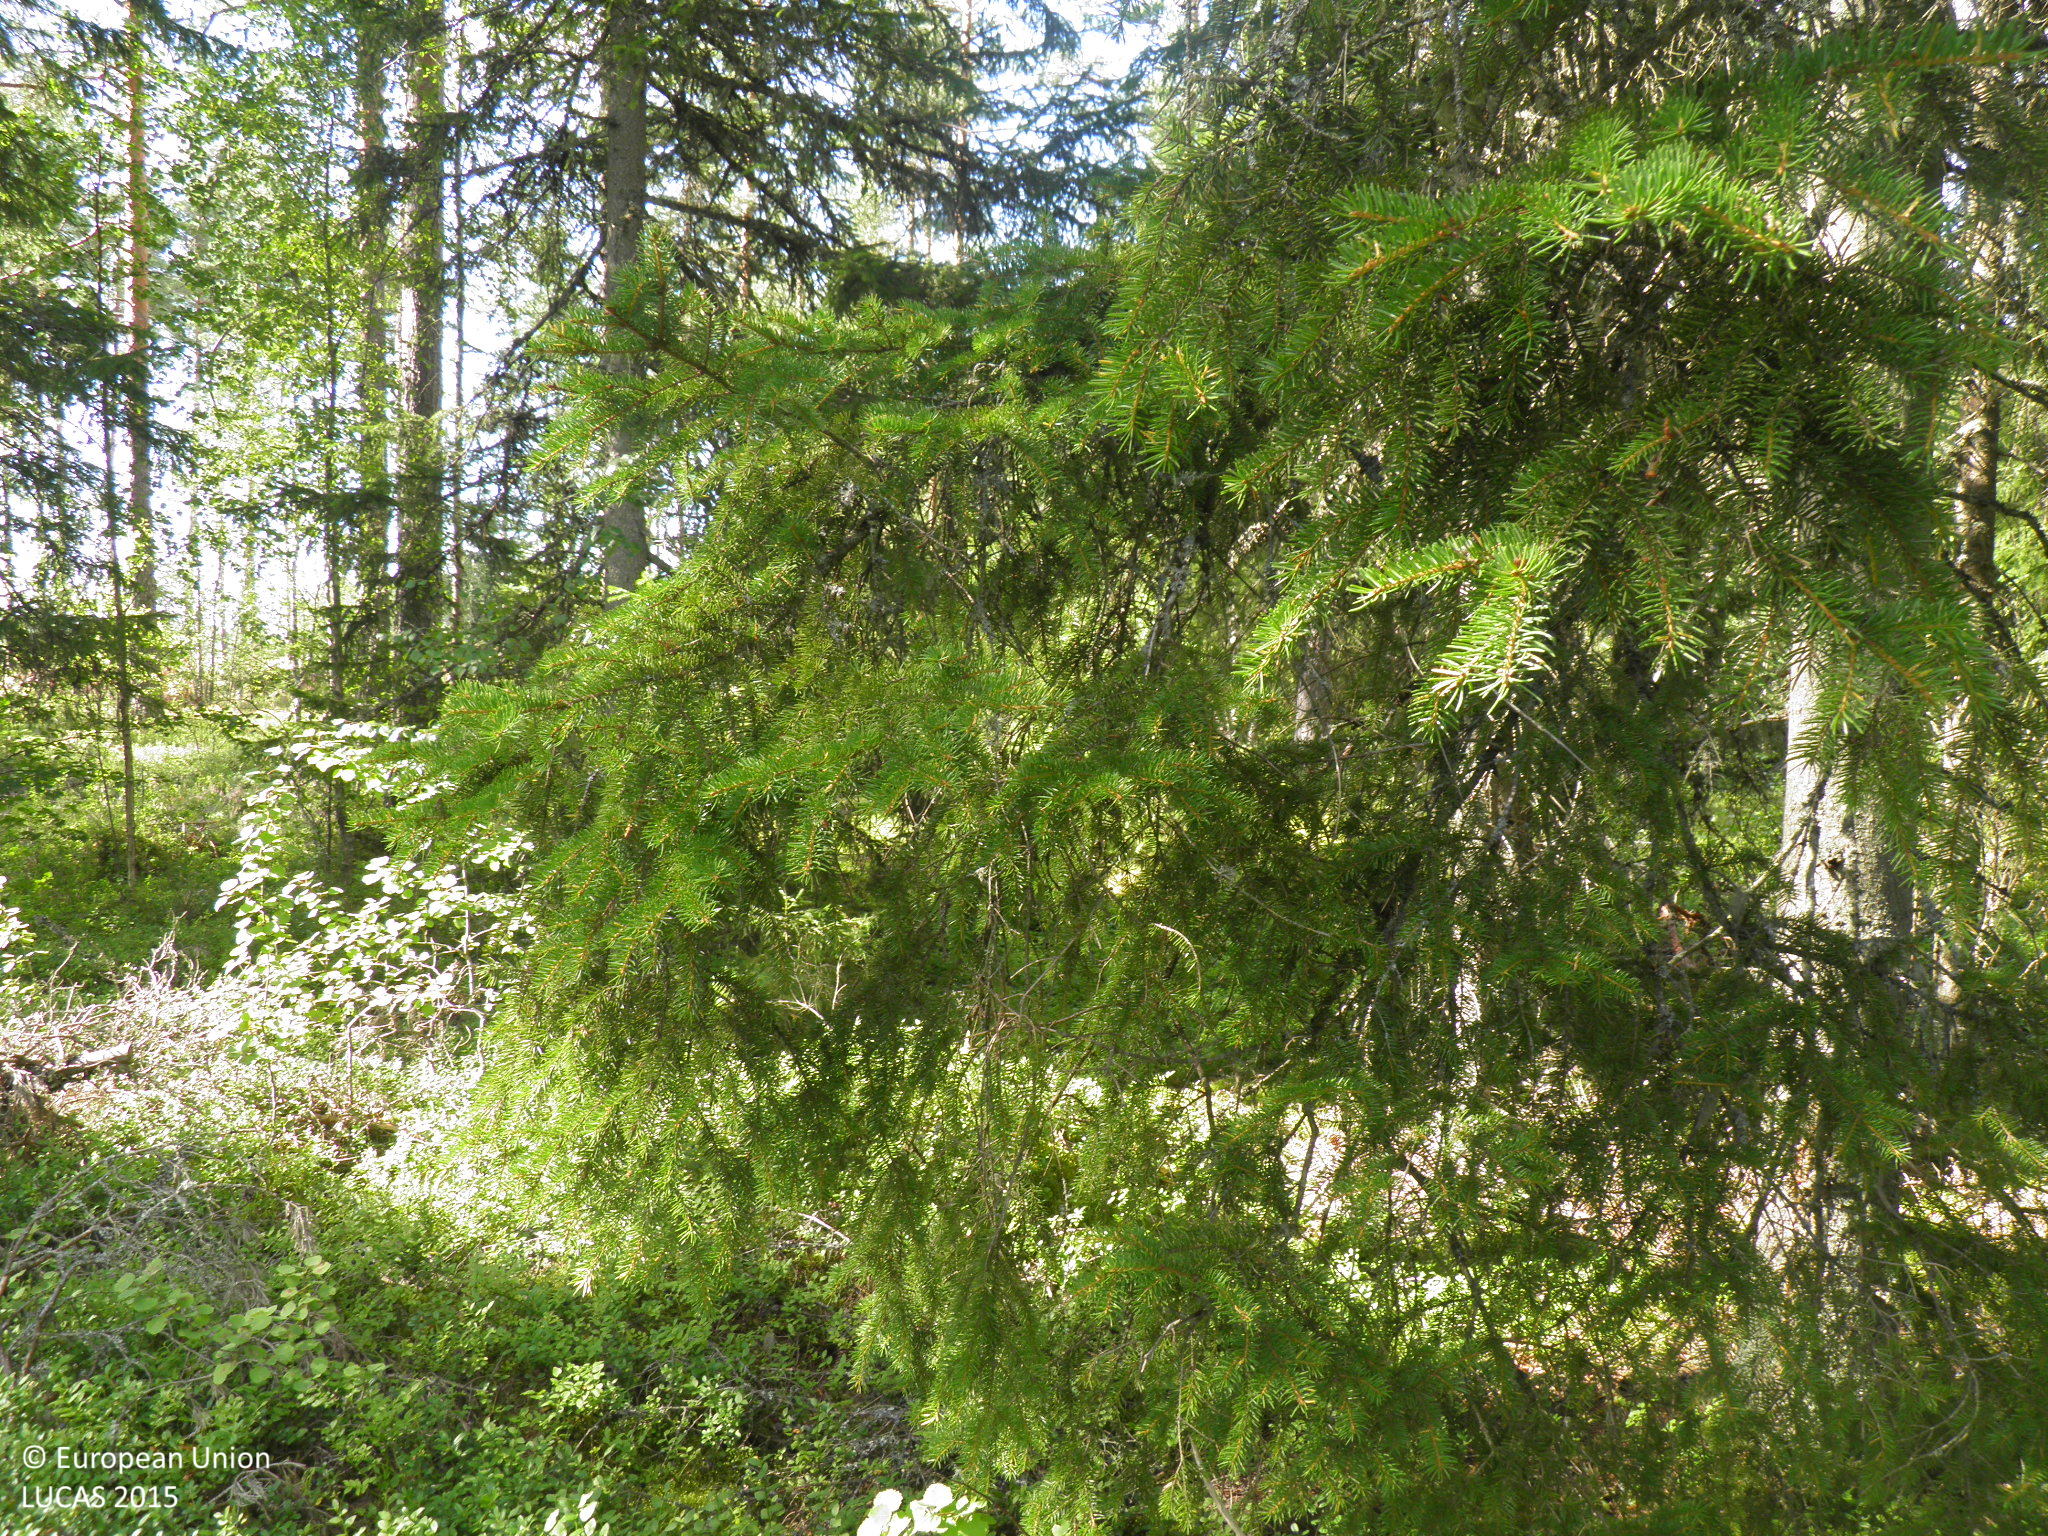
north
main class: Woodland
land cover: Spruce dominated coniferous woodland
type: hemiboreal forest and nemoral coniferous forest and mixed broadleaved-coniferous forest
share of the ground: 50 - 75 %
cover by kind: coniferous forest trees 70 %, shrubs 15 %, lichens and mosses 15 %
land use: Forestry
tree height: > 5 m
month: August
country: FI
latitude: 61.0291
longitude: 21.8472
